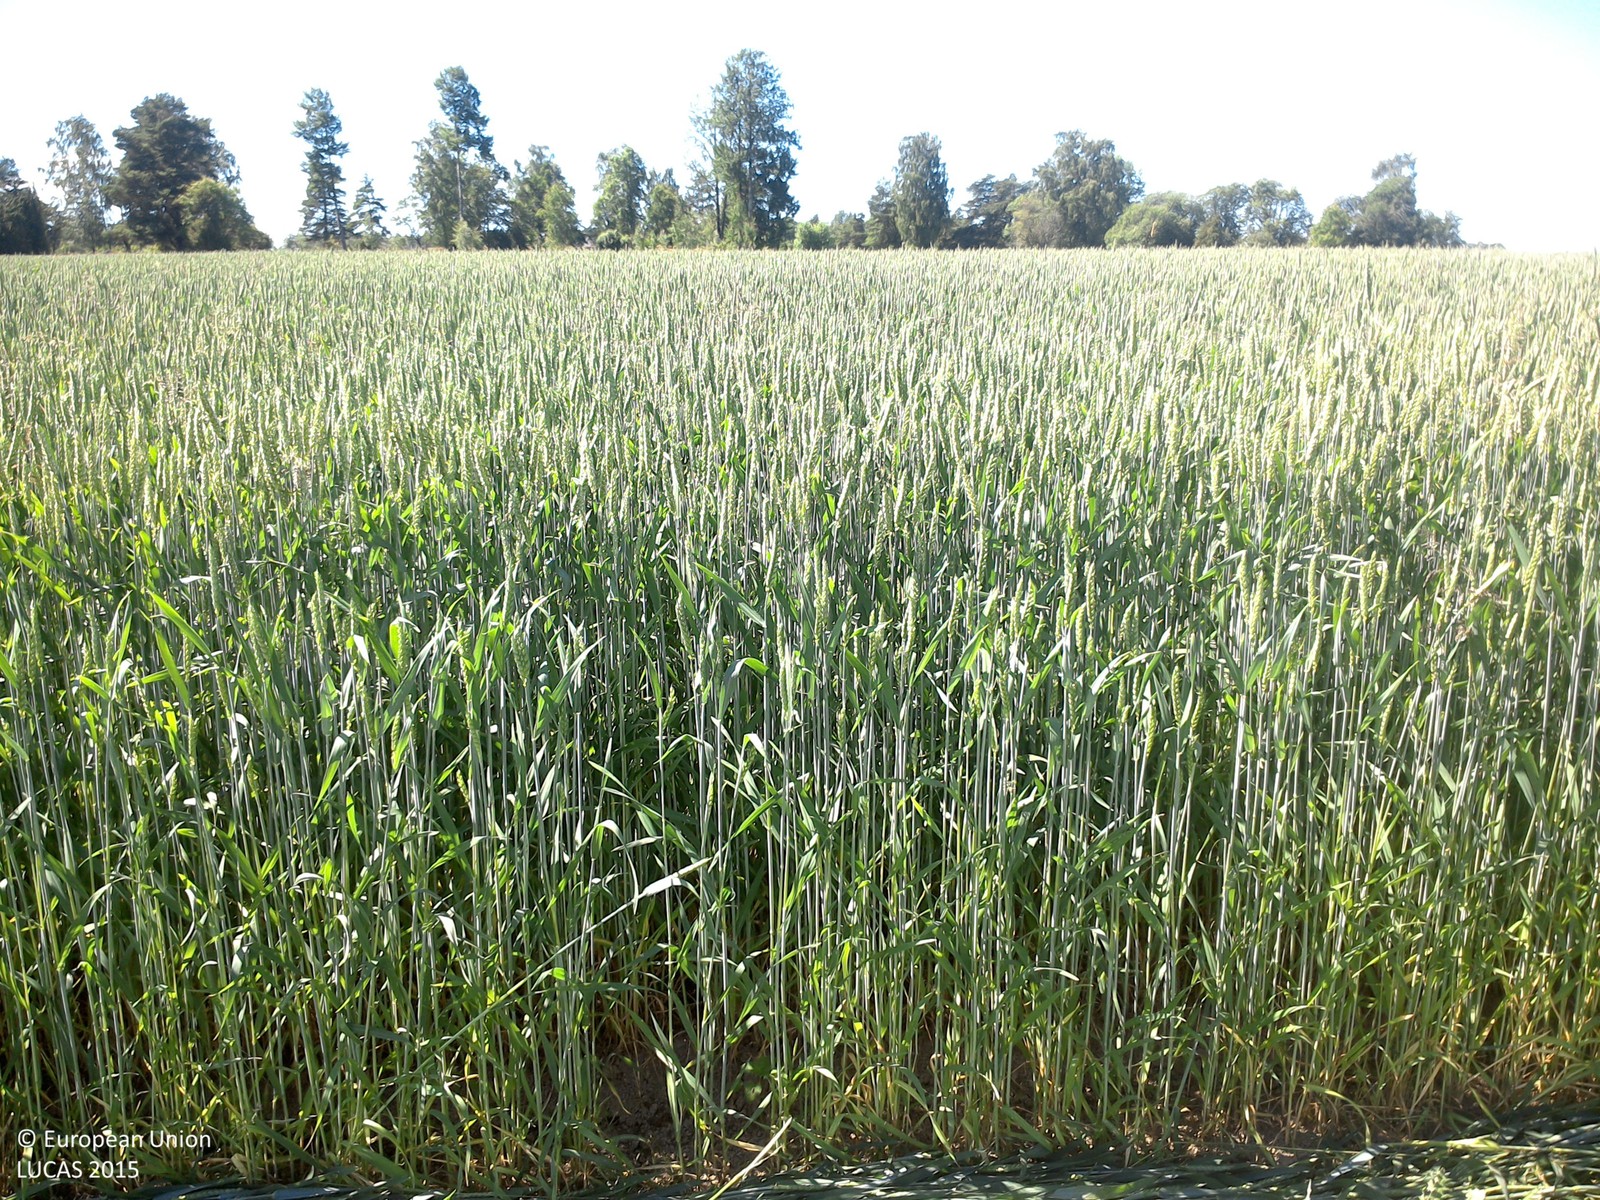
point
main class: Cropland
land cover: Common wheat
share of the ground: > 75 %
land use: Agriculture (excluding fallow land and kitchen gardens)
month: July
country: SE
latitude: 58.3616
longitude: 15.4468
